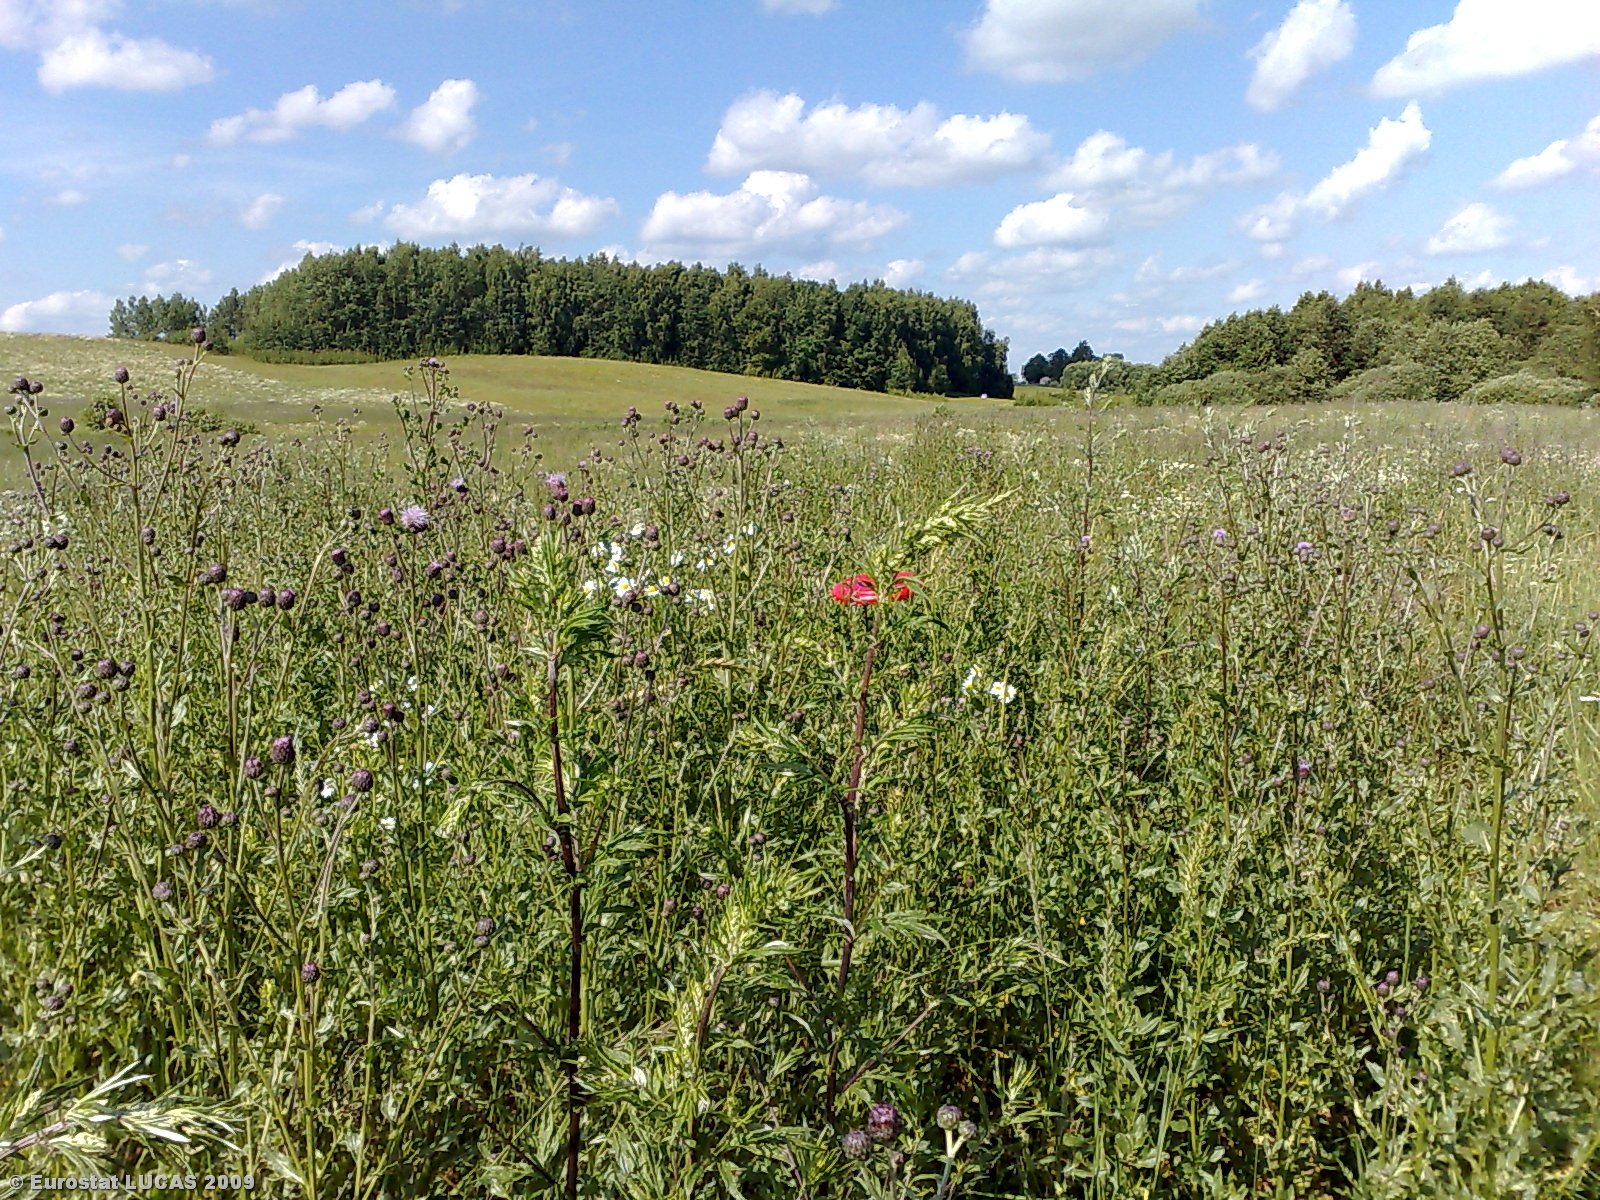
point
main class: Grassland
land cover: Grassland without tree/shrub cover
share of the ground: > 75 %
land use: Agriculture (excluding fallow land and kitchen gardens)
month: July
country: LT
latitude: 55.5120
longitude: 22.7494
